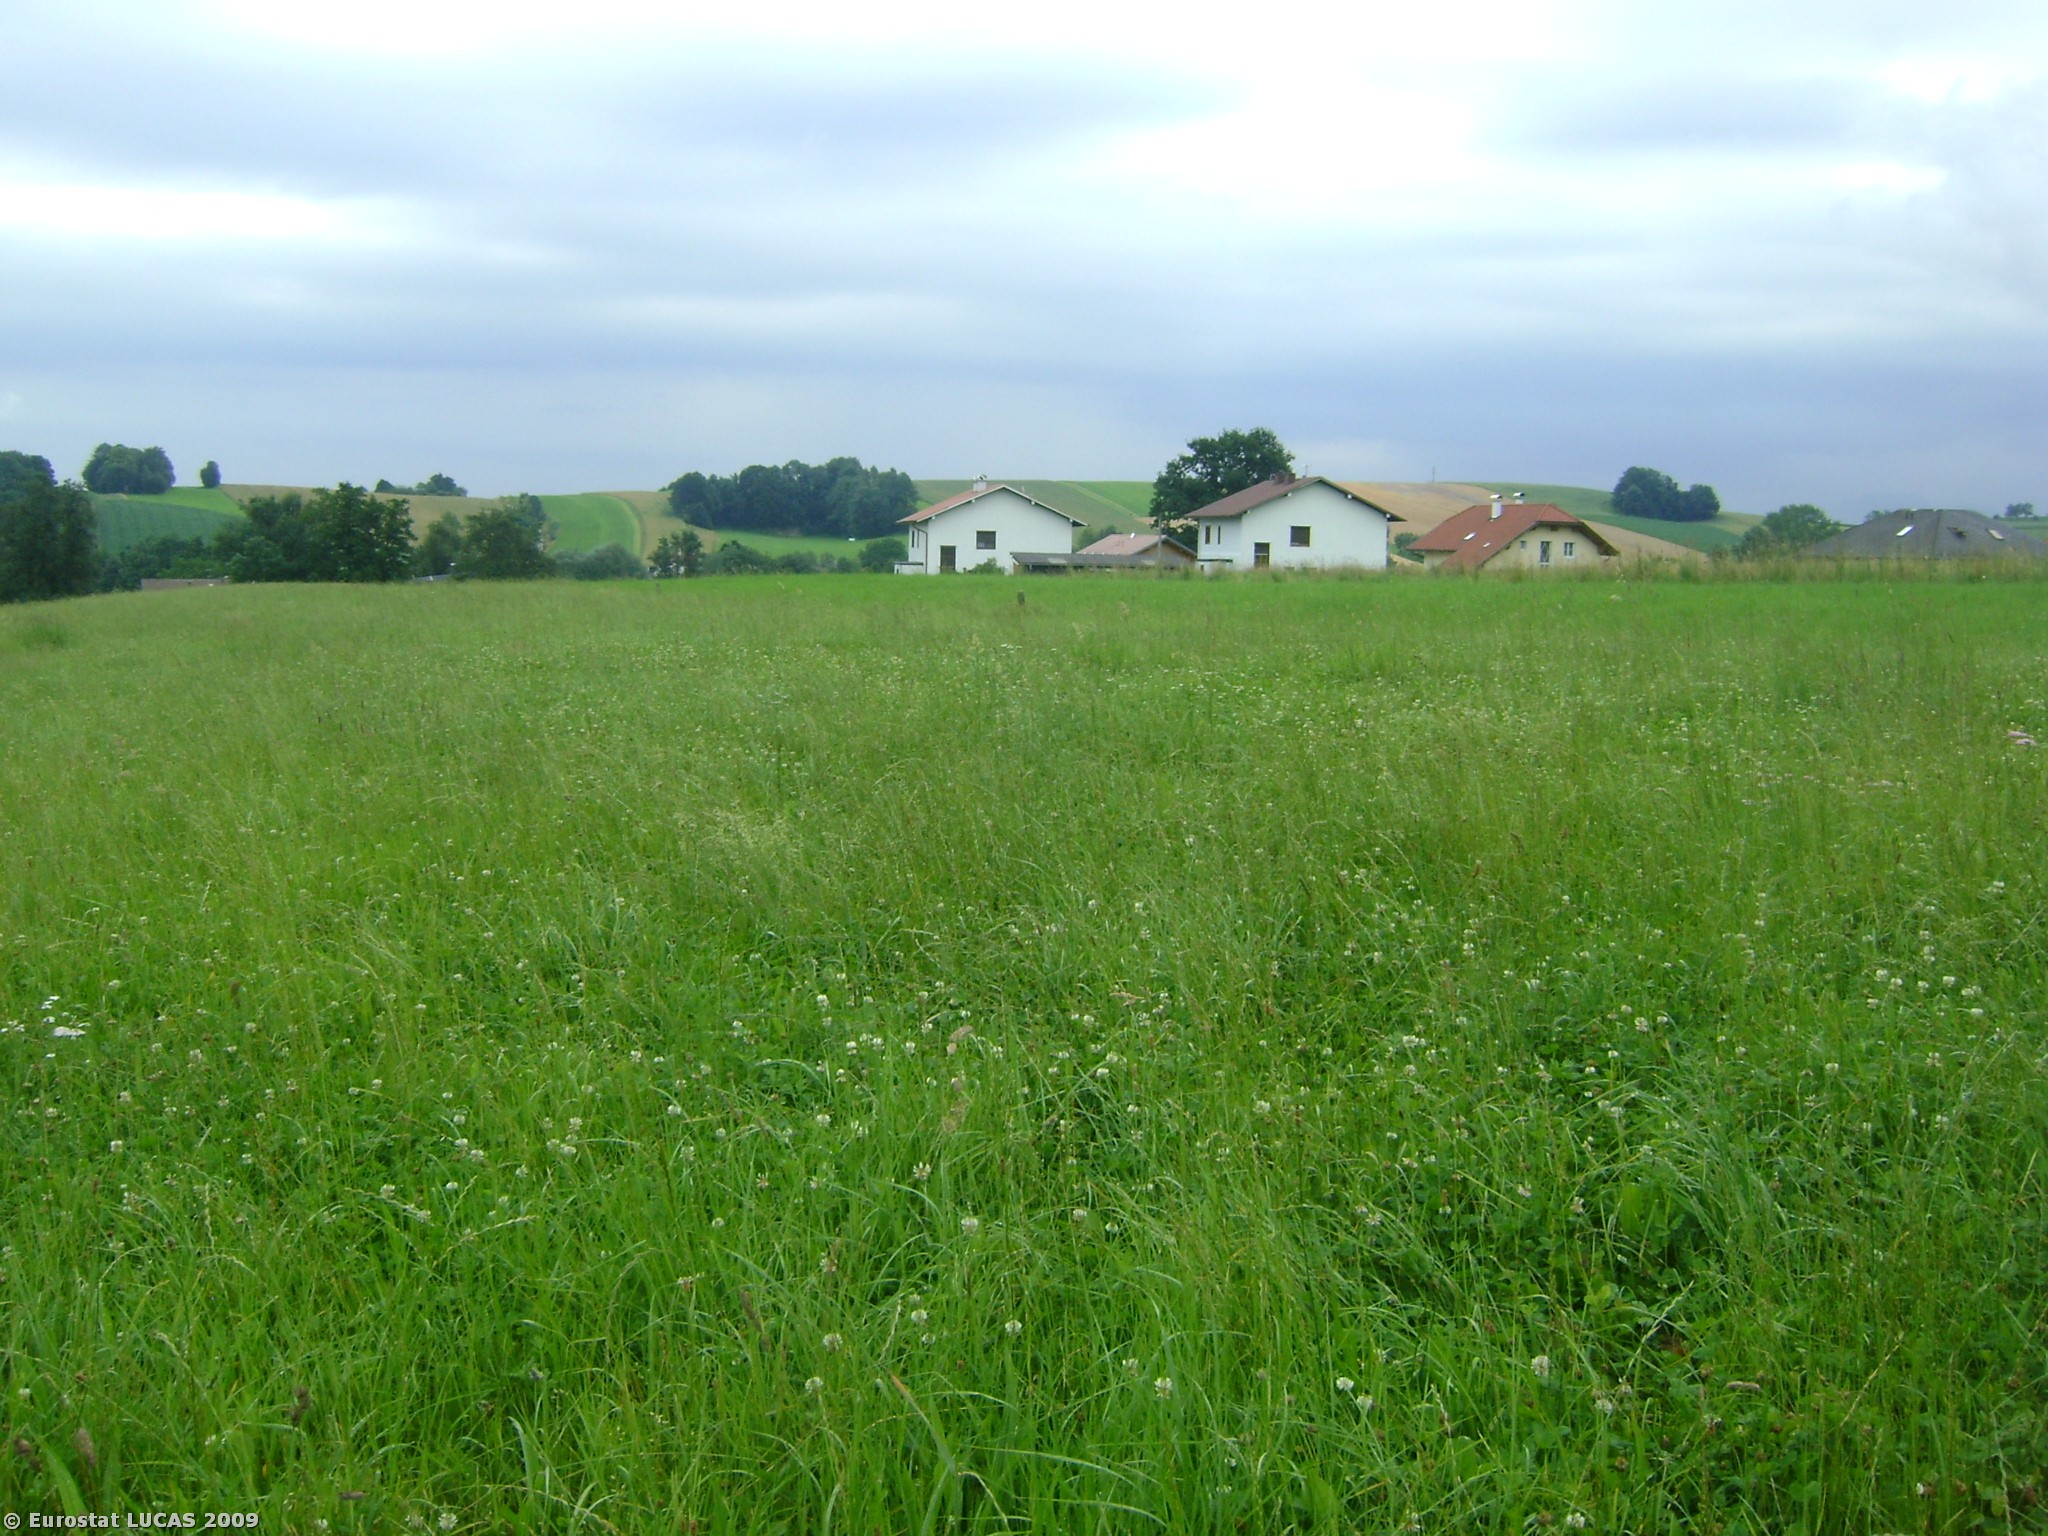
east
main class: Grassland
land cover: Grassland without tree/shrub cover
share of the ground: > 75 %
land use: Agriculture (excluding fallow land and kitchen gardens)
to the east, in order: Grassland without tree/shrub cover; Fences; Artificial constructions in urban areas; Tracks; Grassland without tree/shrub cover
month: July
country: AT
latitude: 48.1931
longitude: 13.2681
